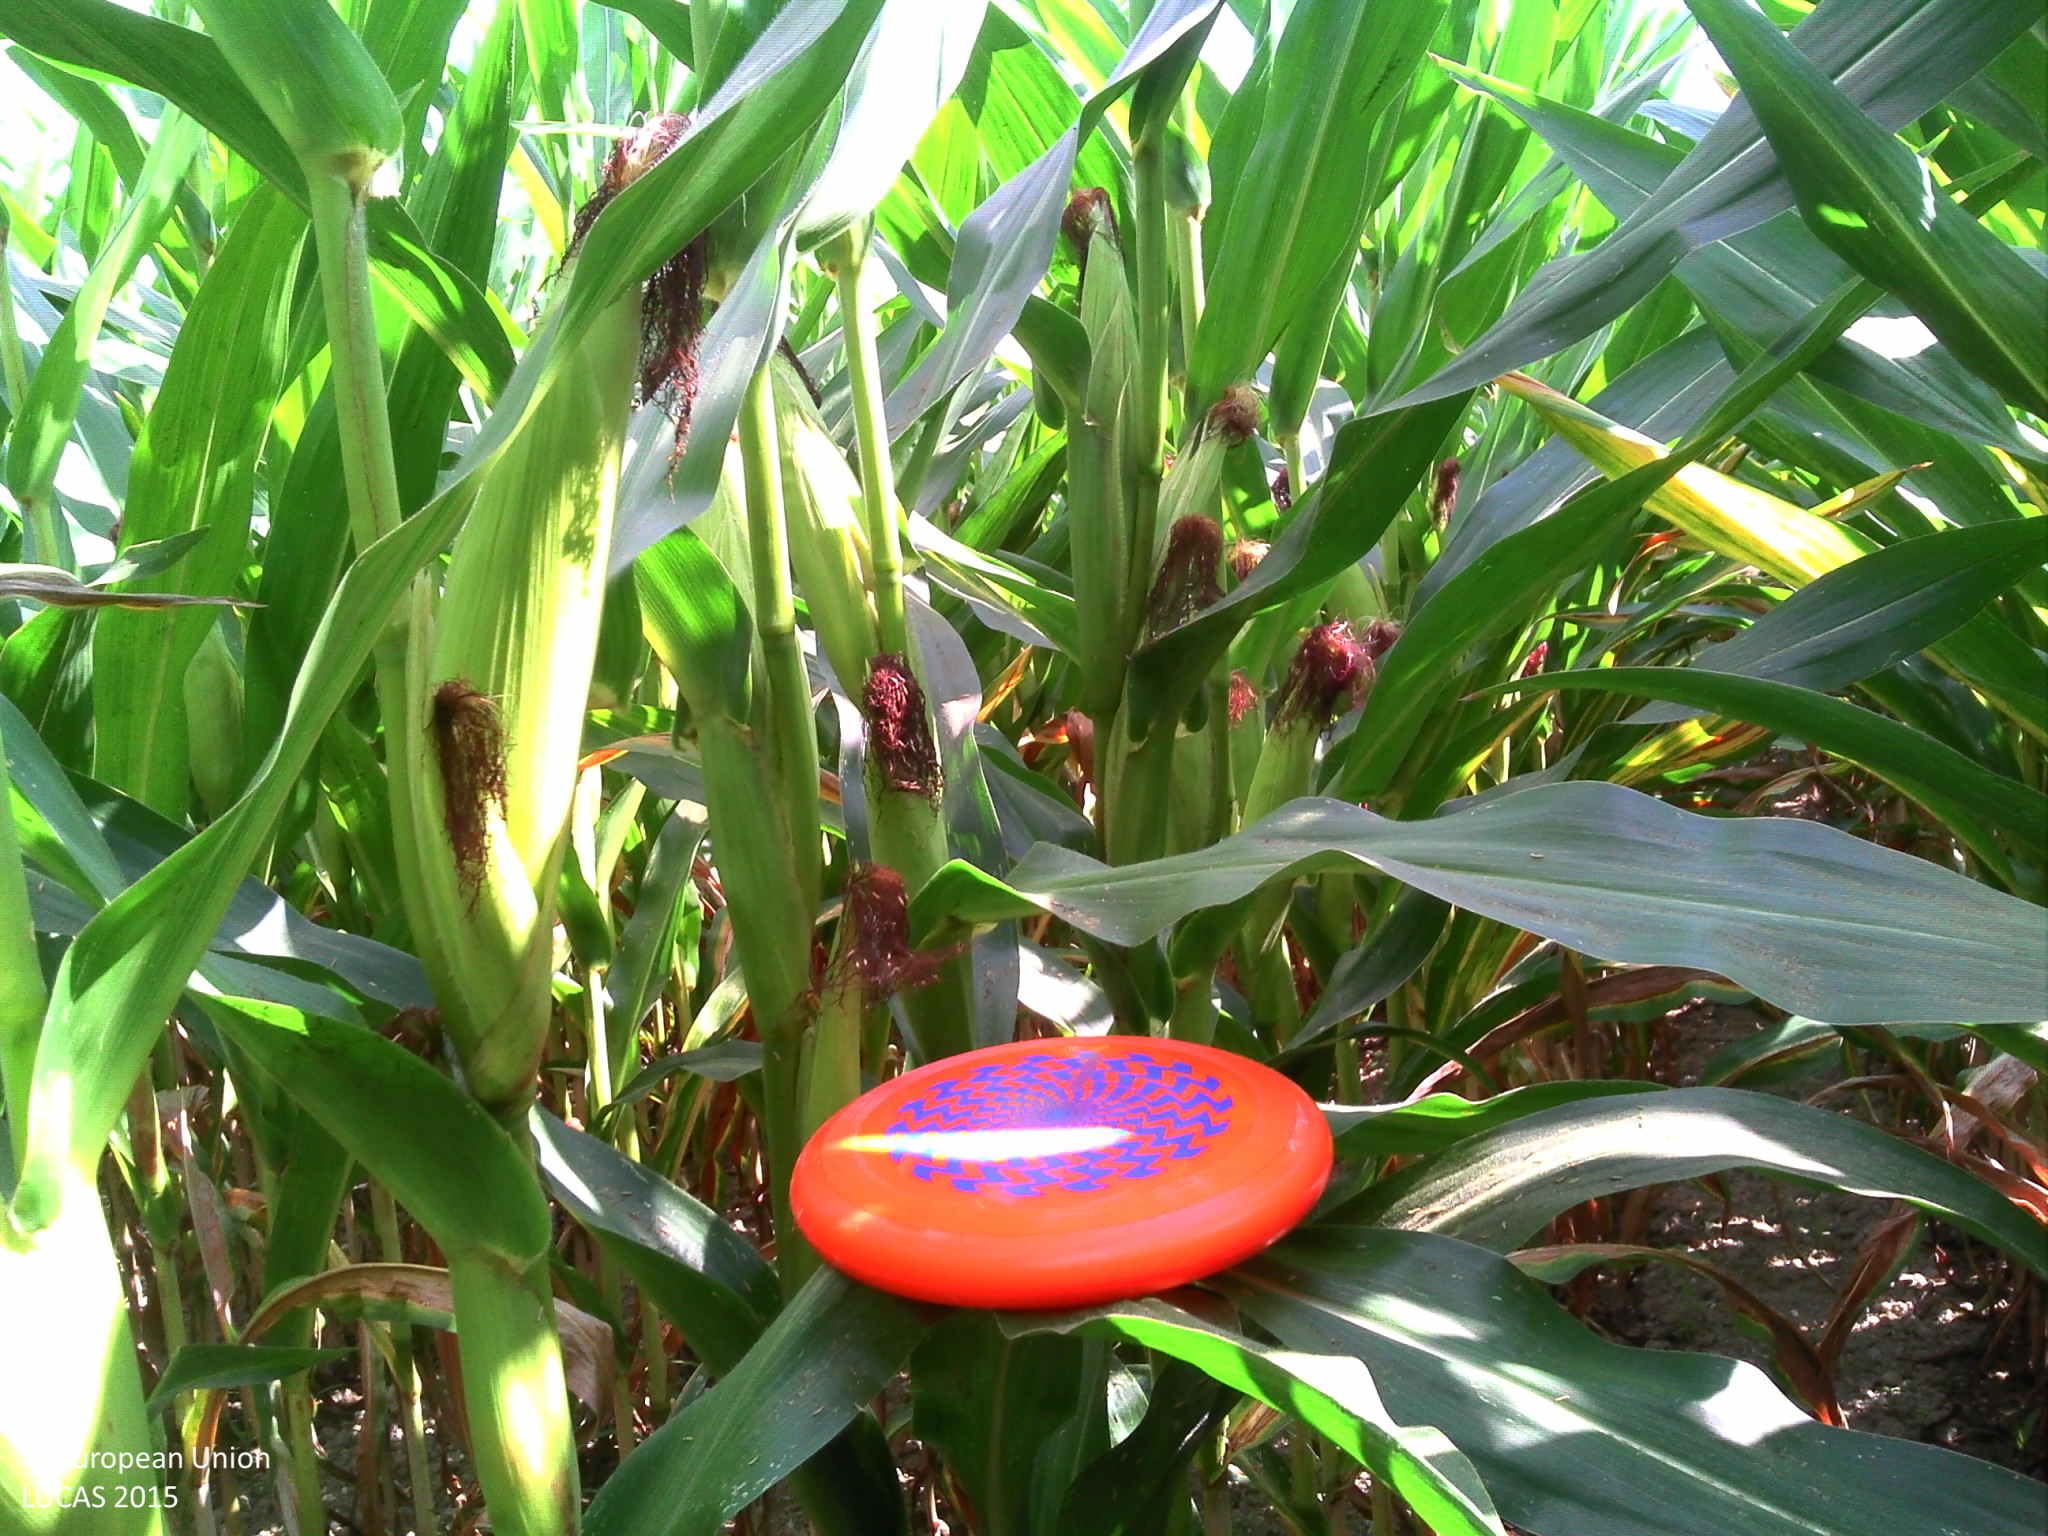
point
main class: Cropland
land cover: Maize
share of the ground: > 75 %
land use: Agriculture (excluding fallow land and kitchen gardens)
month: August
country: FR
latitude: 48.3156
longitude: -2.1242
